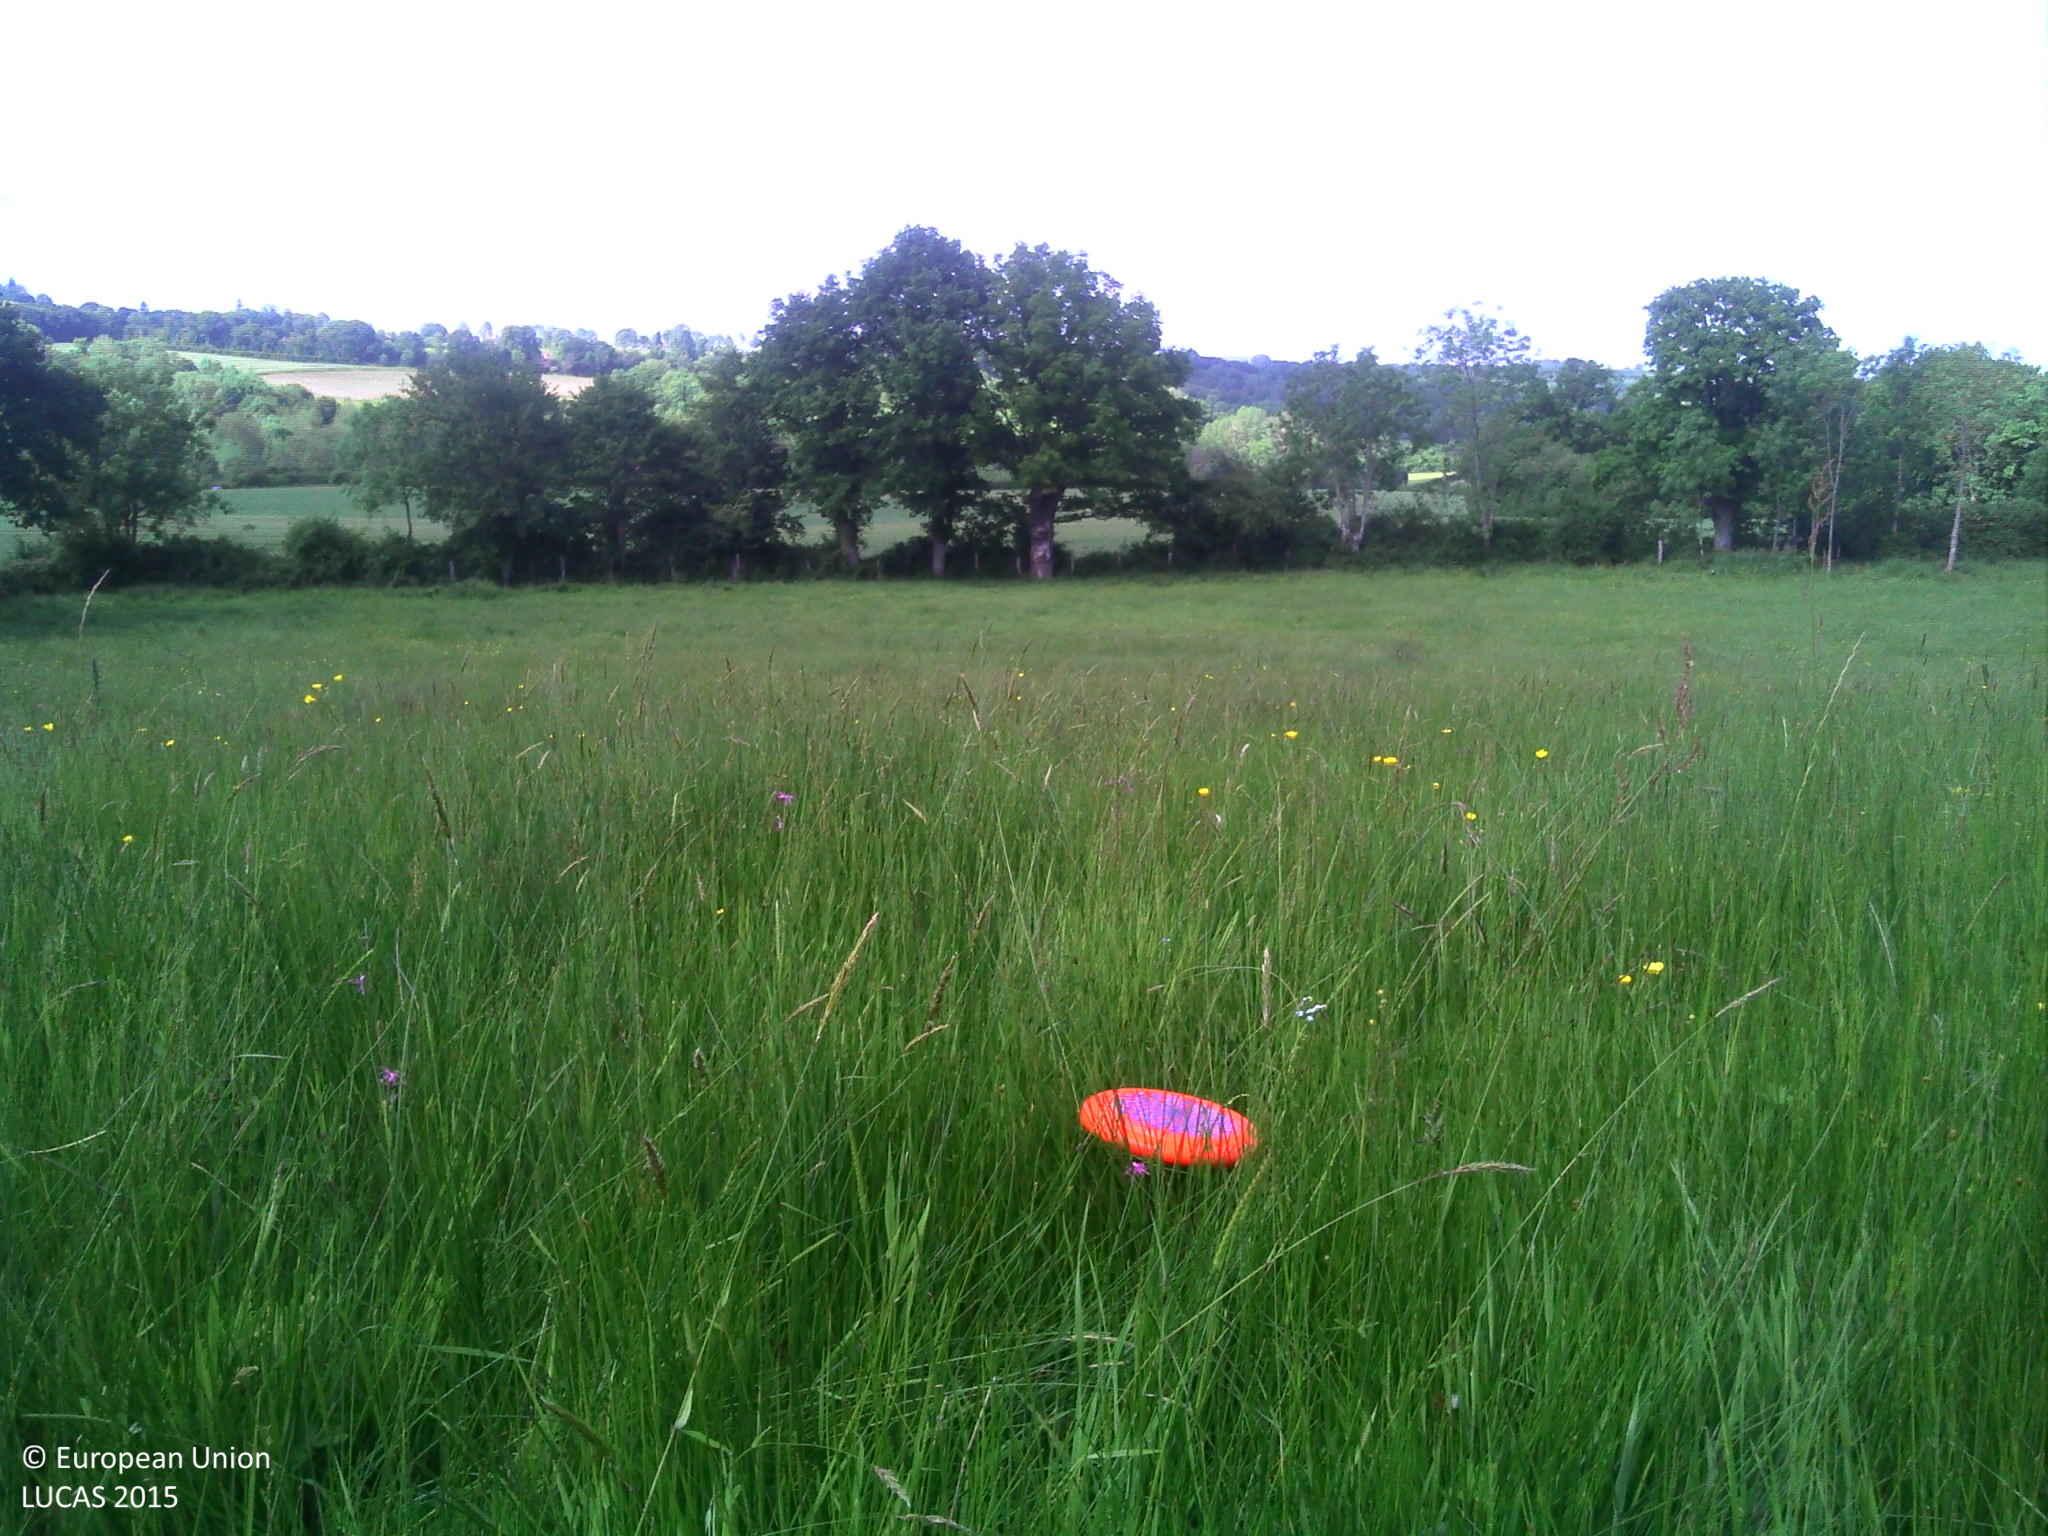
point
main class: Grassland
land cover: Grassland without tree/shrub cover
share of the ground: > 75 %
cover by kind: herbaceous plants 90 %, shrubs 5 %
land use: Agriculture (excluding fallow land and kitchen gardens)
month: June
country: FR
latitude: 48.8349
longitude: 0.1759
